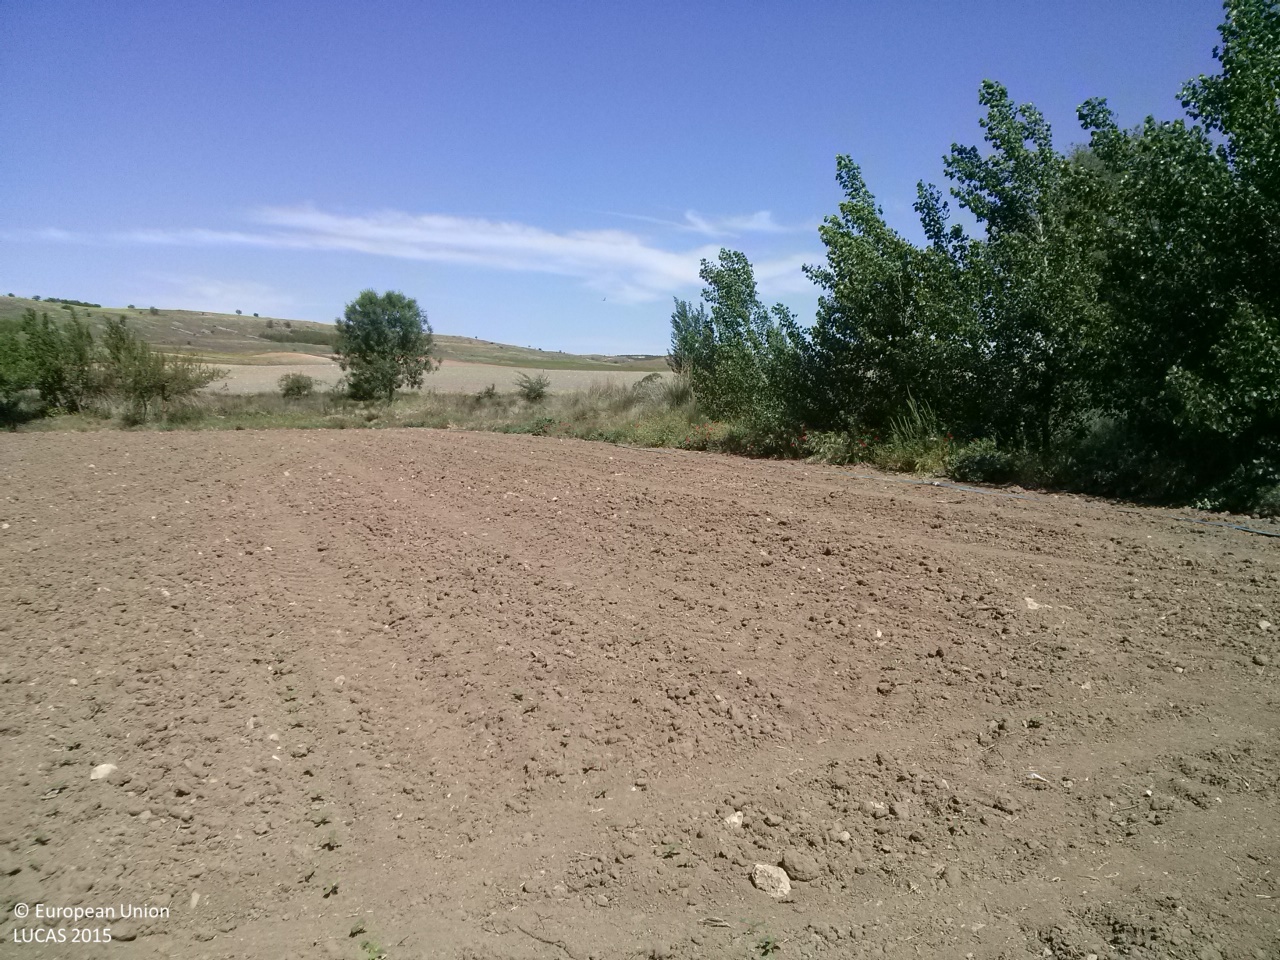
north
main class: Cropland
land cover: Sunflower
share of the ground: < 10 %
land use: Agriculture (excluding fallow land and kitchen gardens)
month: May
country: ES
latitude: 39.9863
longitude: -2.8452
